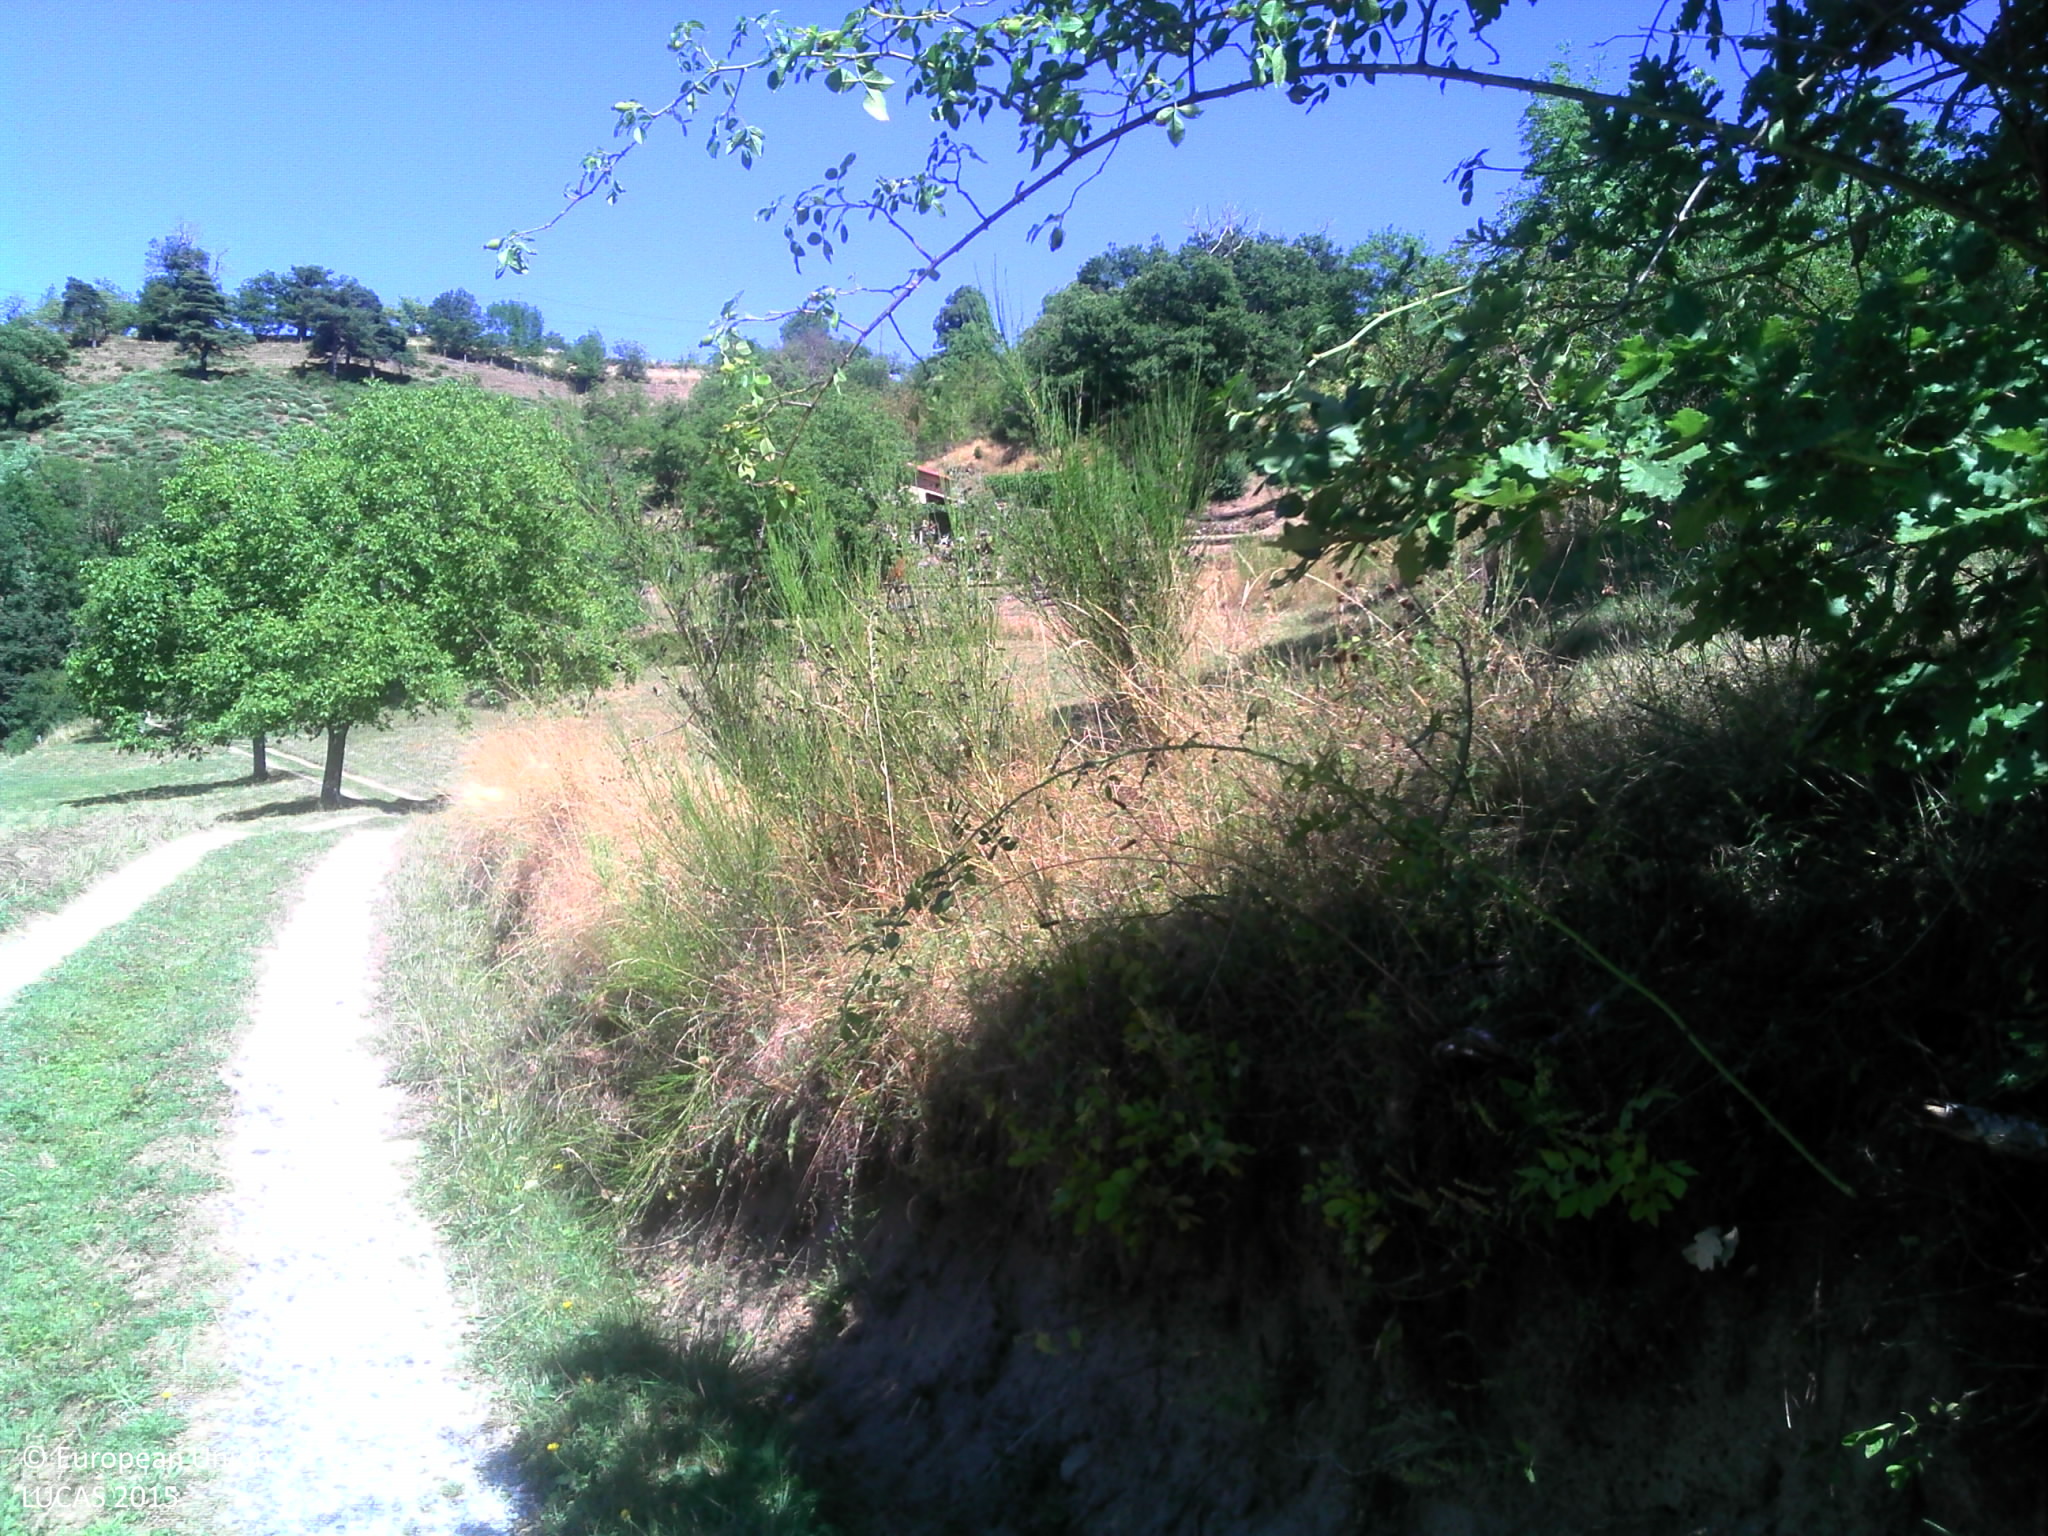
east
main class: Woodland
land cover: Broadleaved woodland
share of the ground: > 75 %
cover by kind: broadleaved forest trees 70 %, herbaceous plants 30 %
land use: Semi-natural and natural areas not in use
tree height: > 5 m
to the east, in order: Broadleaved woodland; Grassland with sparse tree/shrub cover; Artificial constructions in urban areas; Grassland with sparse tree/shrub cover; Paved roads, cycling and walking lanes; Grass margins; Grassland with sparse tree/shrub cover; Artificial constructions in urban areas; Grassland with sparse tree/shrub cover
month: July
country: FR
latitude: 44.9864
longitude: 4.5897
